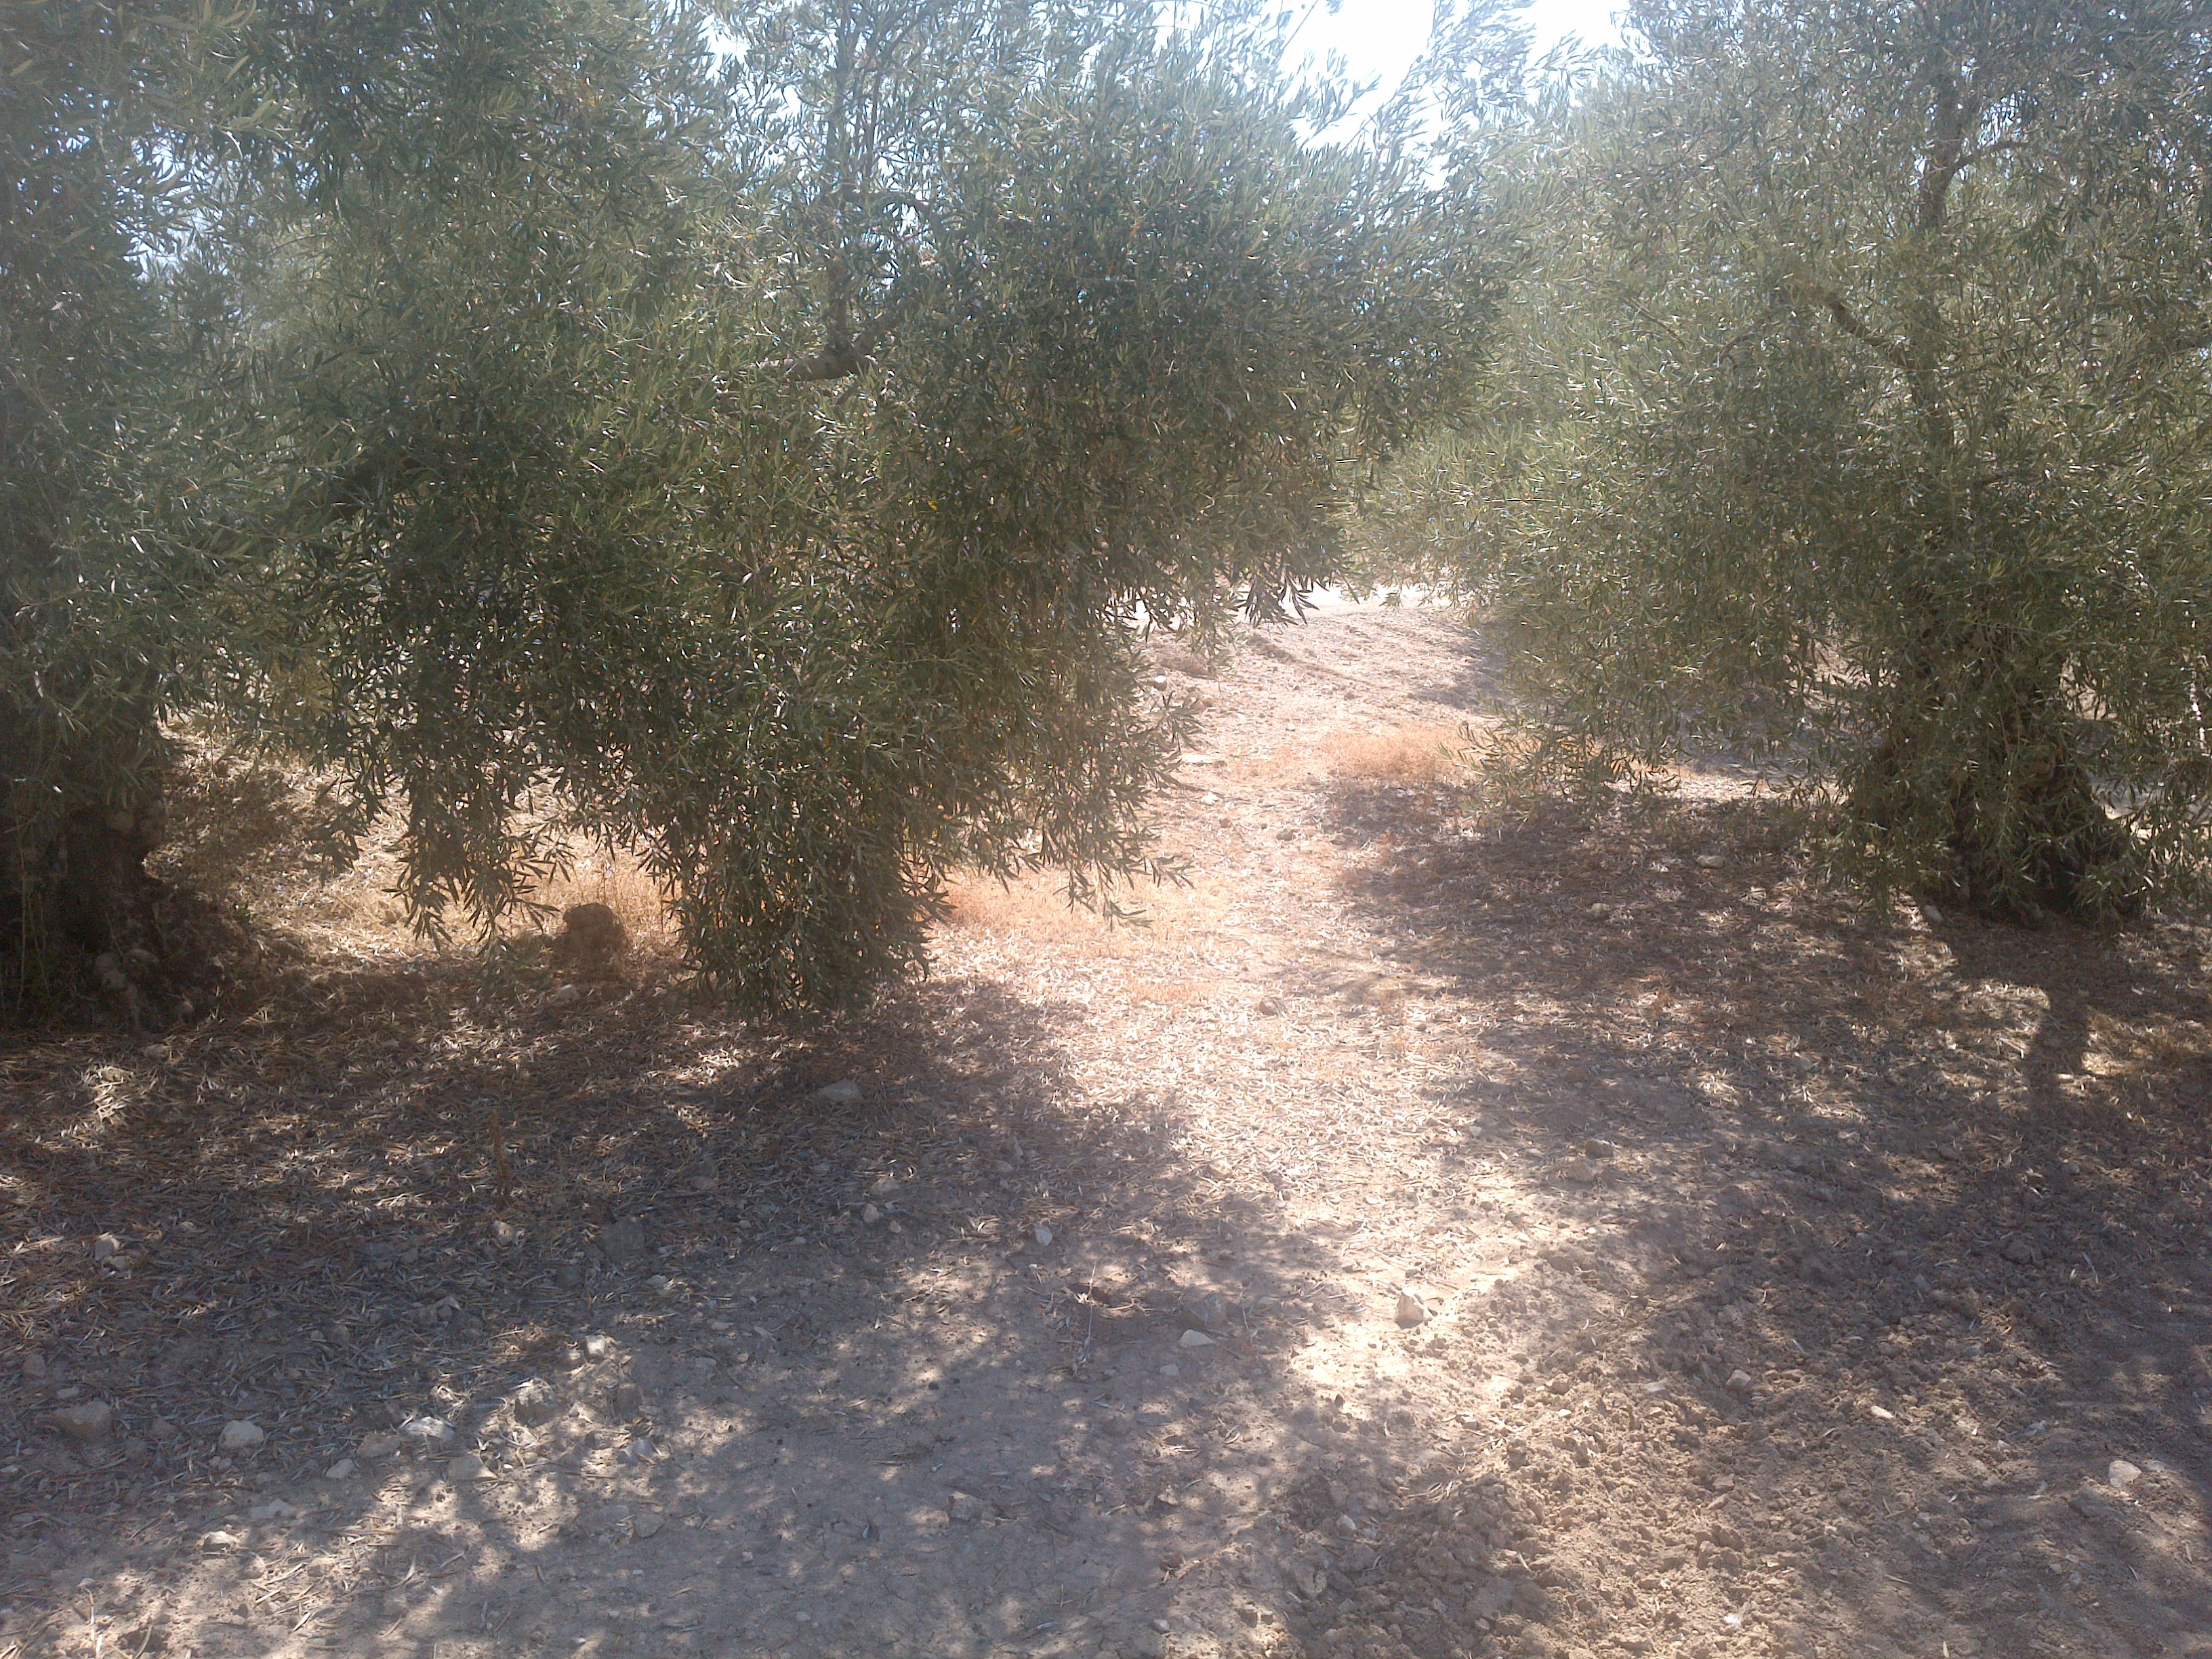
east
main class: Cropland
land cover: Olive groves
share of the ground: 50 - 75 %
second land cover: Other bare soil
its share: > 75 %
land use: Agriculture (excluding fallow land and kitchen gardens)
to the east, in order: Olive groves; Other bare soil; Paved roads, cycling and walking lanes; Ditches and canals; Olive groves
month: July
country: ES
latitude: 37.4041
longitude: -4.8400
